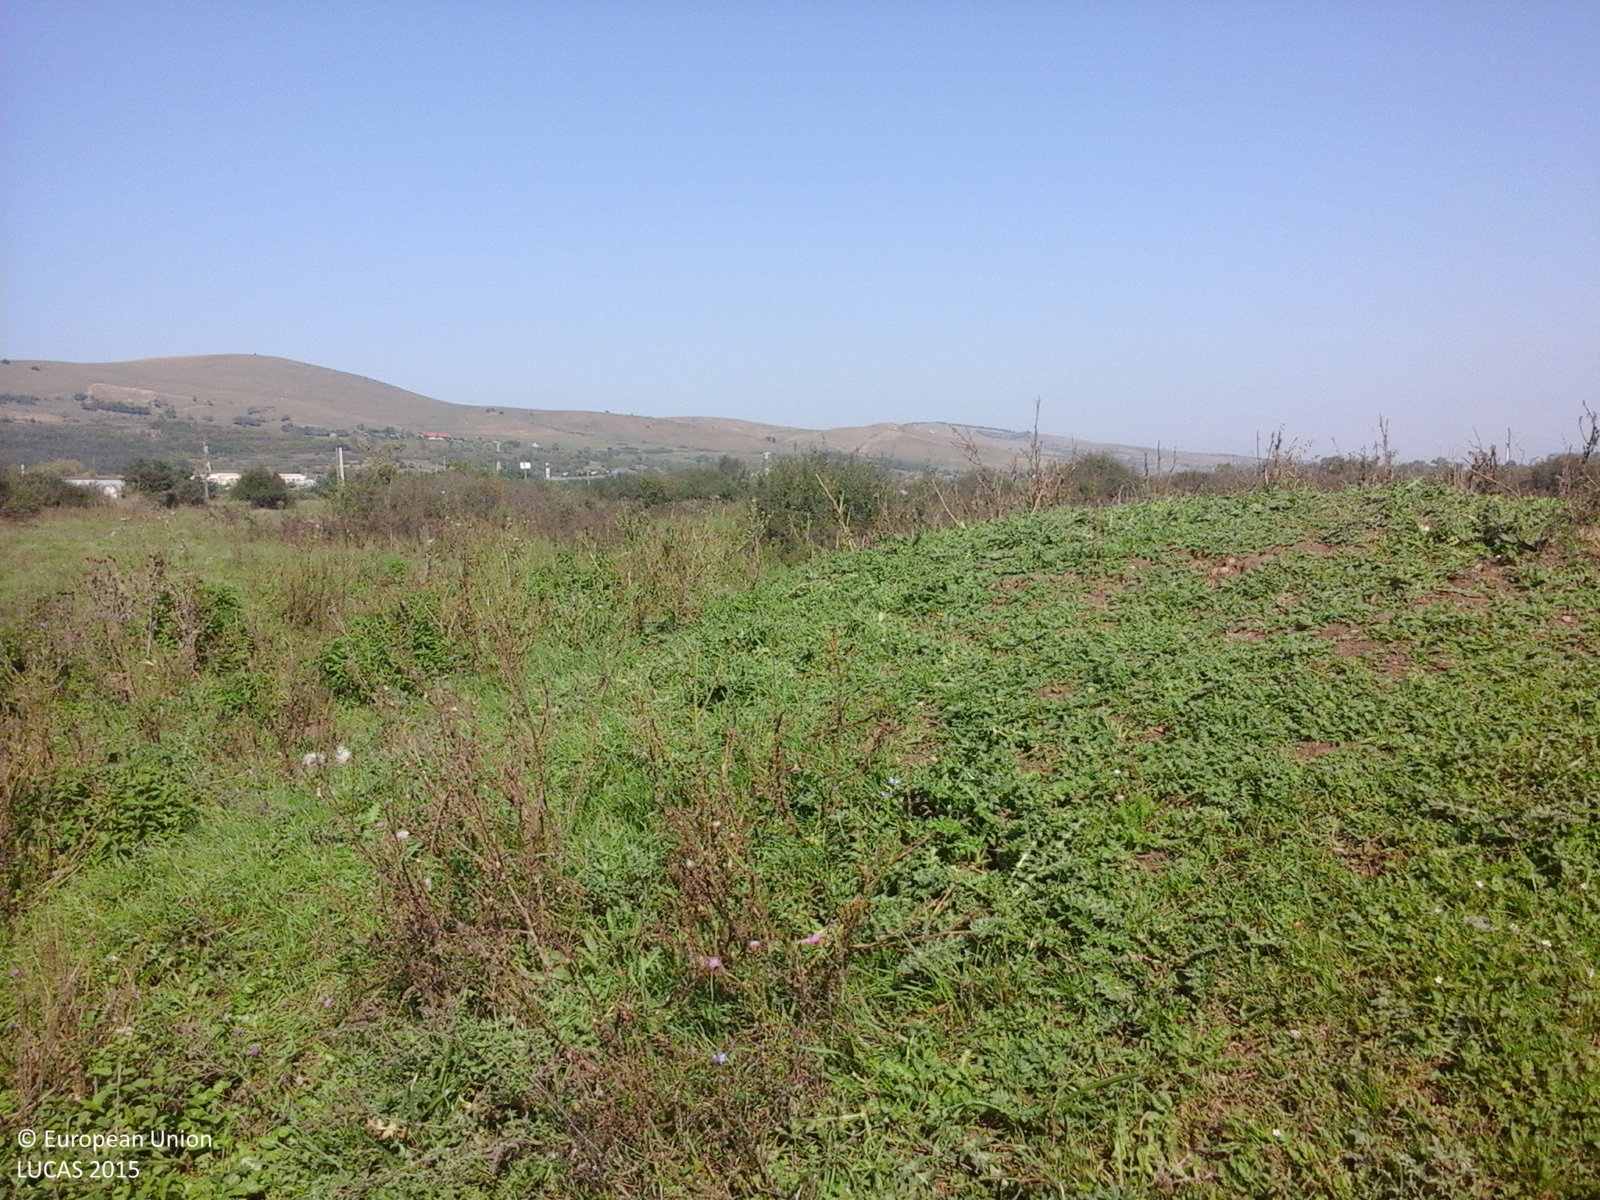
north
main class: Grassland
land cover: Spontaneously vegetated surfaces
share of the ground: > 75 %
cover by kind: herbaceous plants 100 %
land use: Agriculture (excluding fallow land and kitchen gardens)
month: October
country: RO
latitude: 46.0971
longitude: 23.6101
